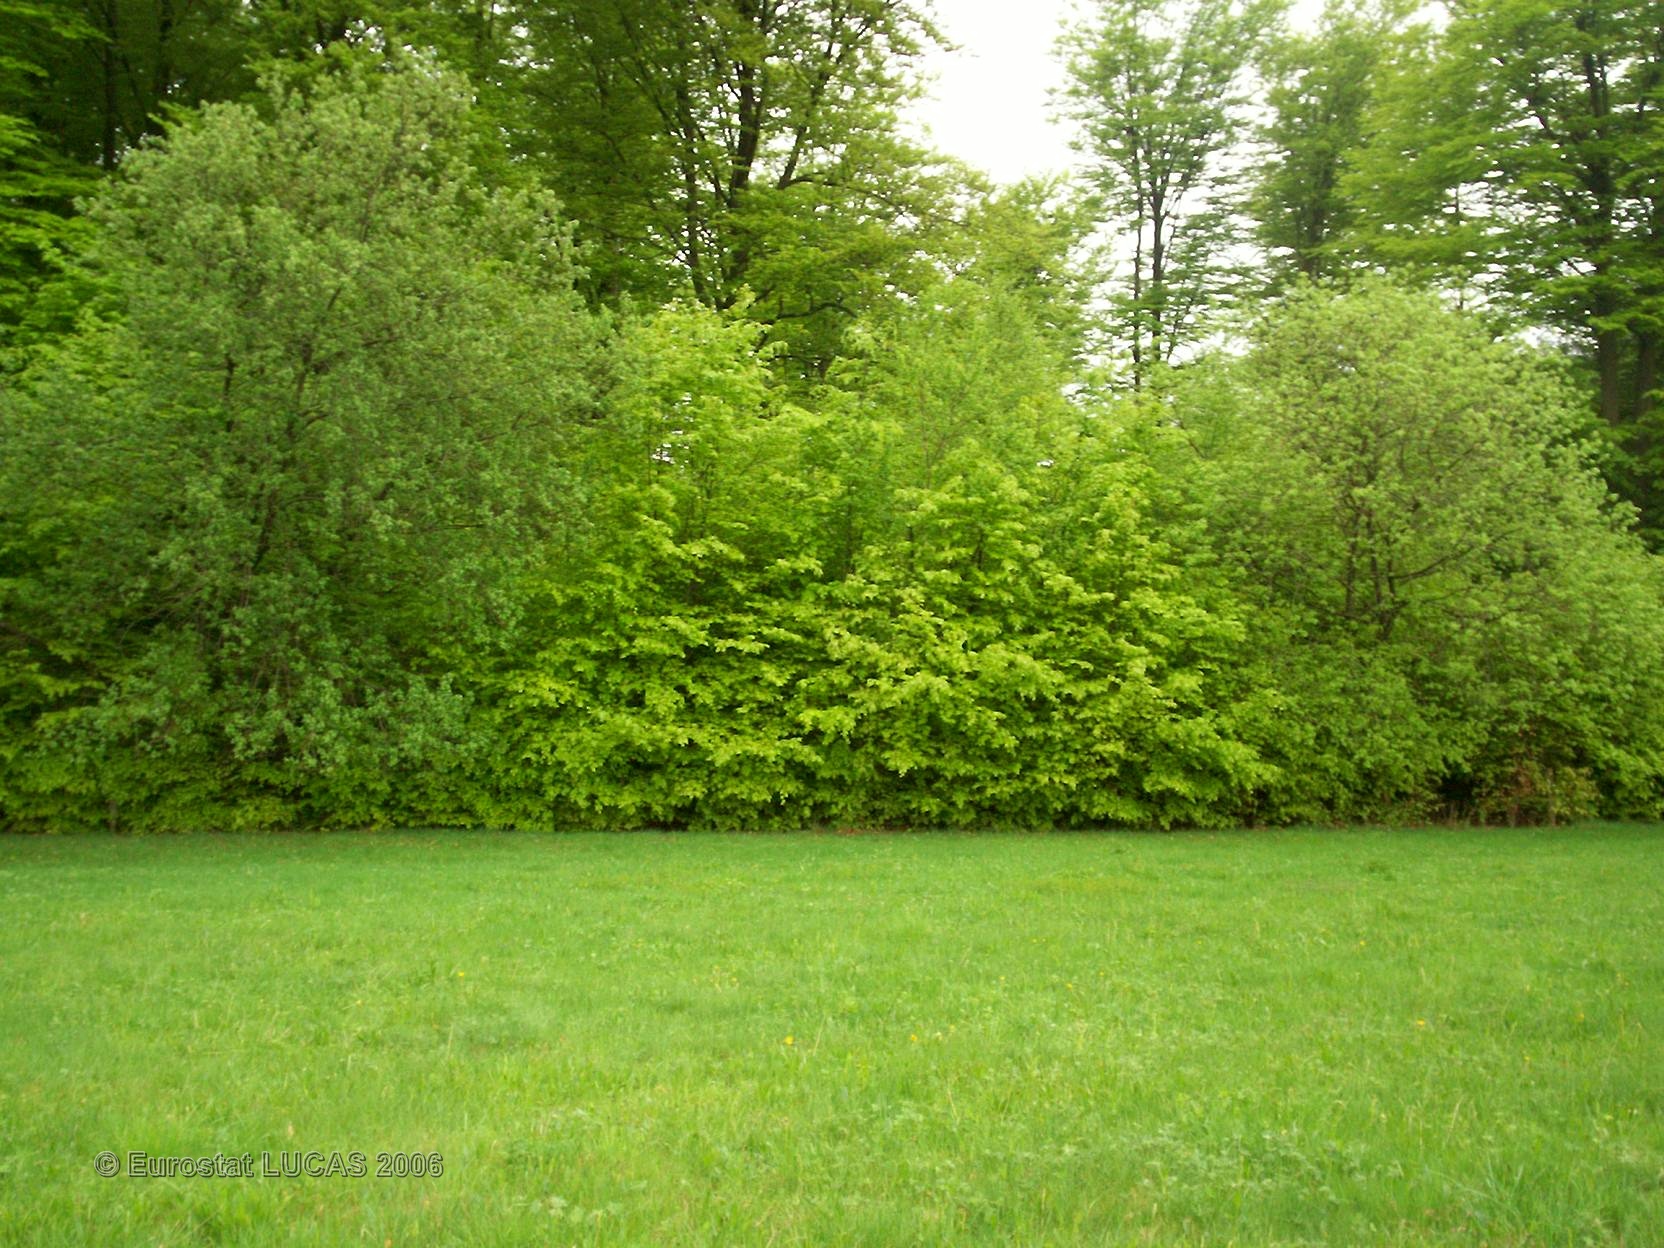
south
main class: Grassland
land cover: Grassland without tree/shrub cover
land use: Agriculture (excluding fallow land and kitchen gardens)
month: May
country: FR
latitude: 48.0008
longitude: 6.3419
